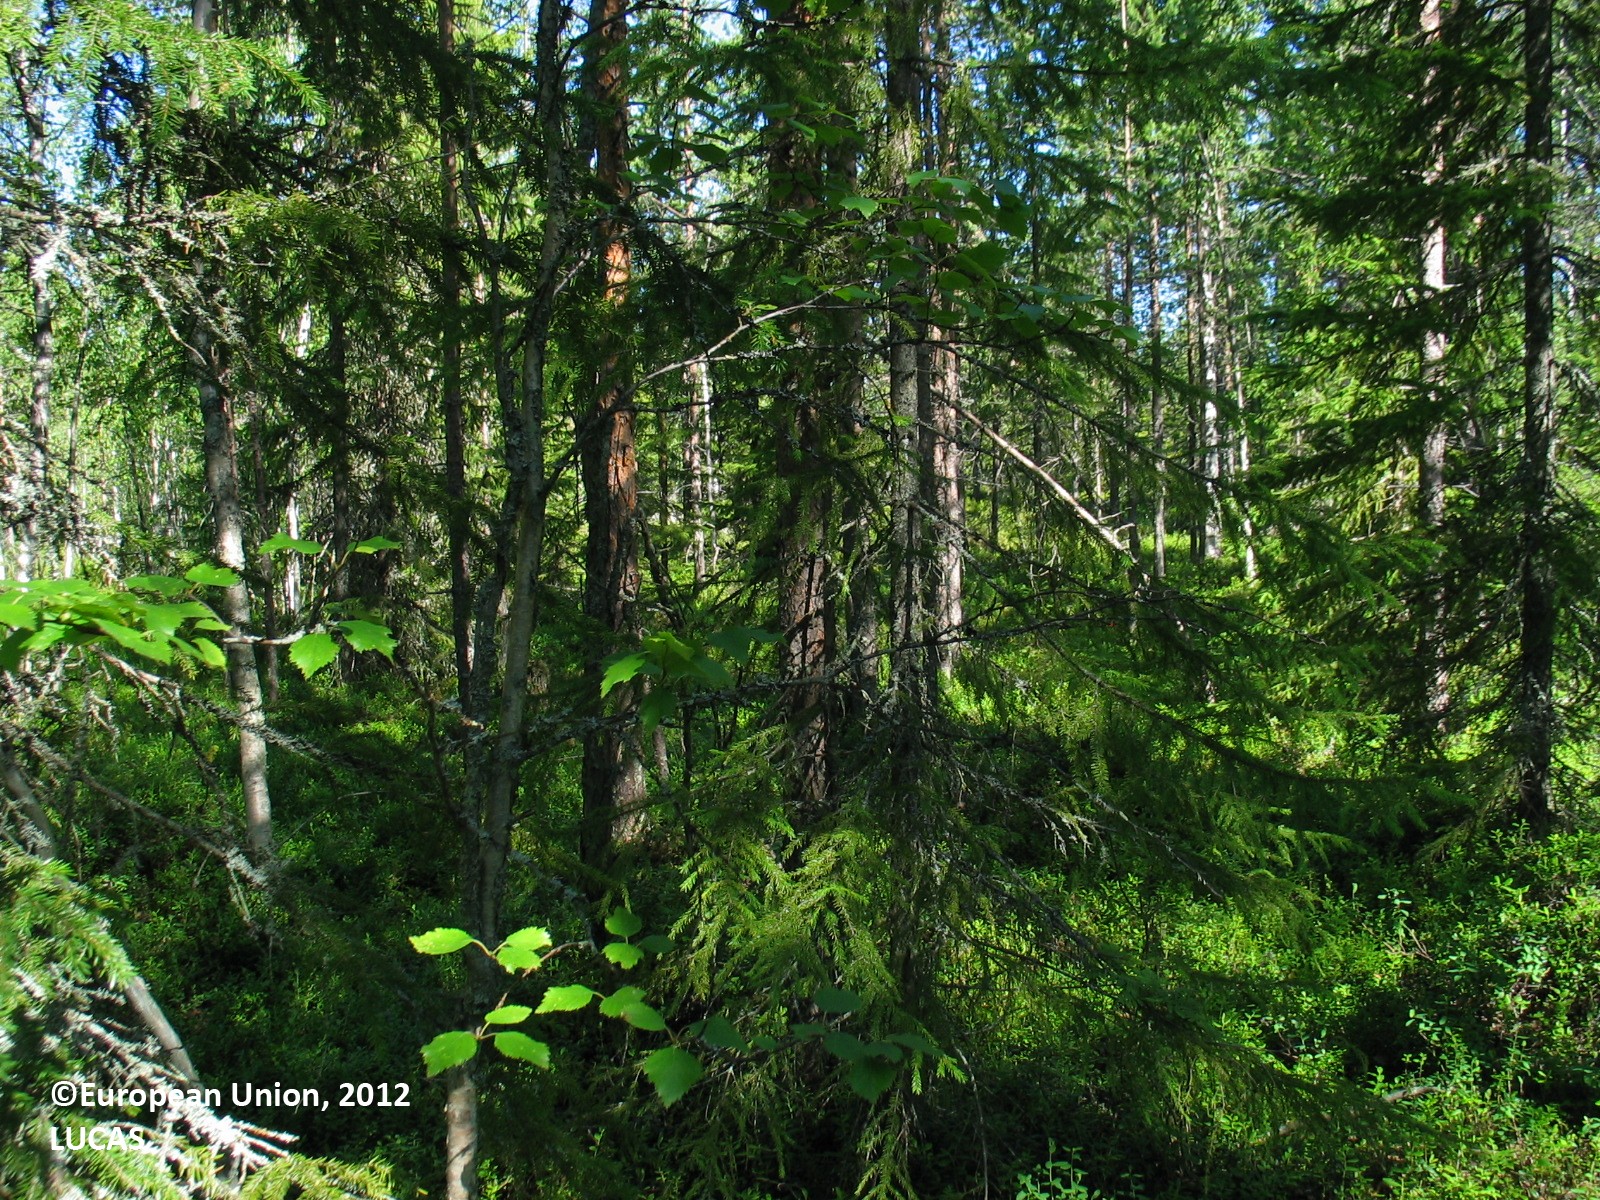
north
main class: Woodland
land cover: Pine dominated mixed woodland
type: boreal forest
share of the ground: 50 - 75 %
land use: Forestry
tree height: > 5 m
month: July
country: FI
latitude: 65.7828
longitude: 25.0297
